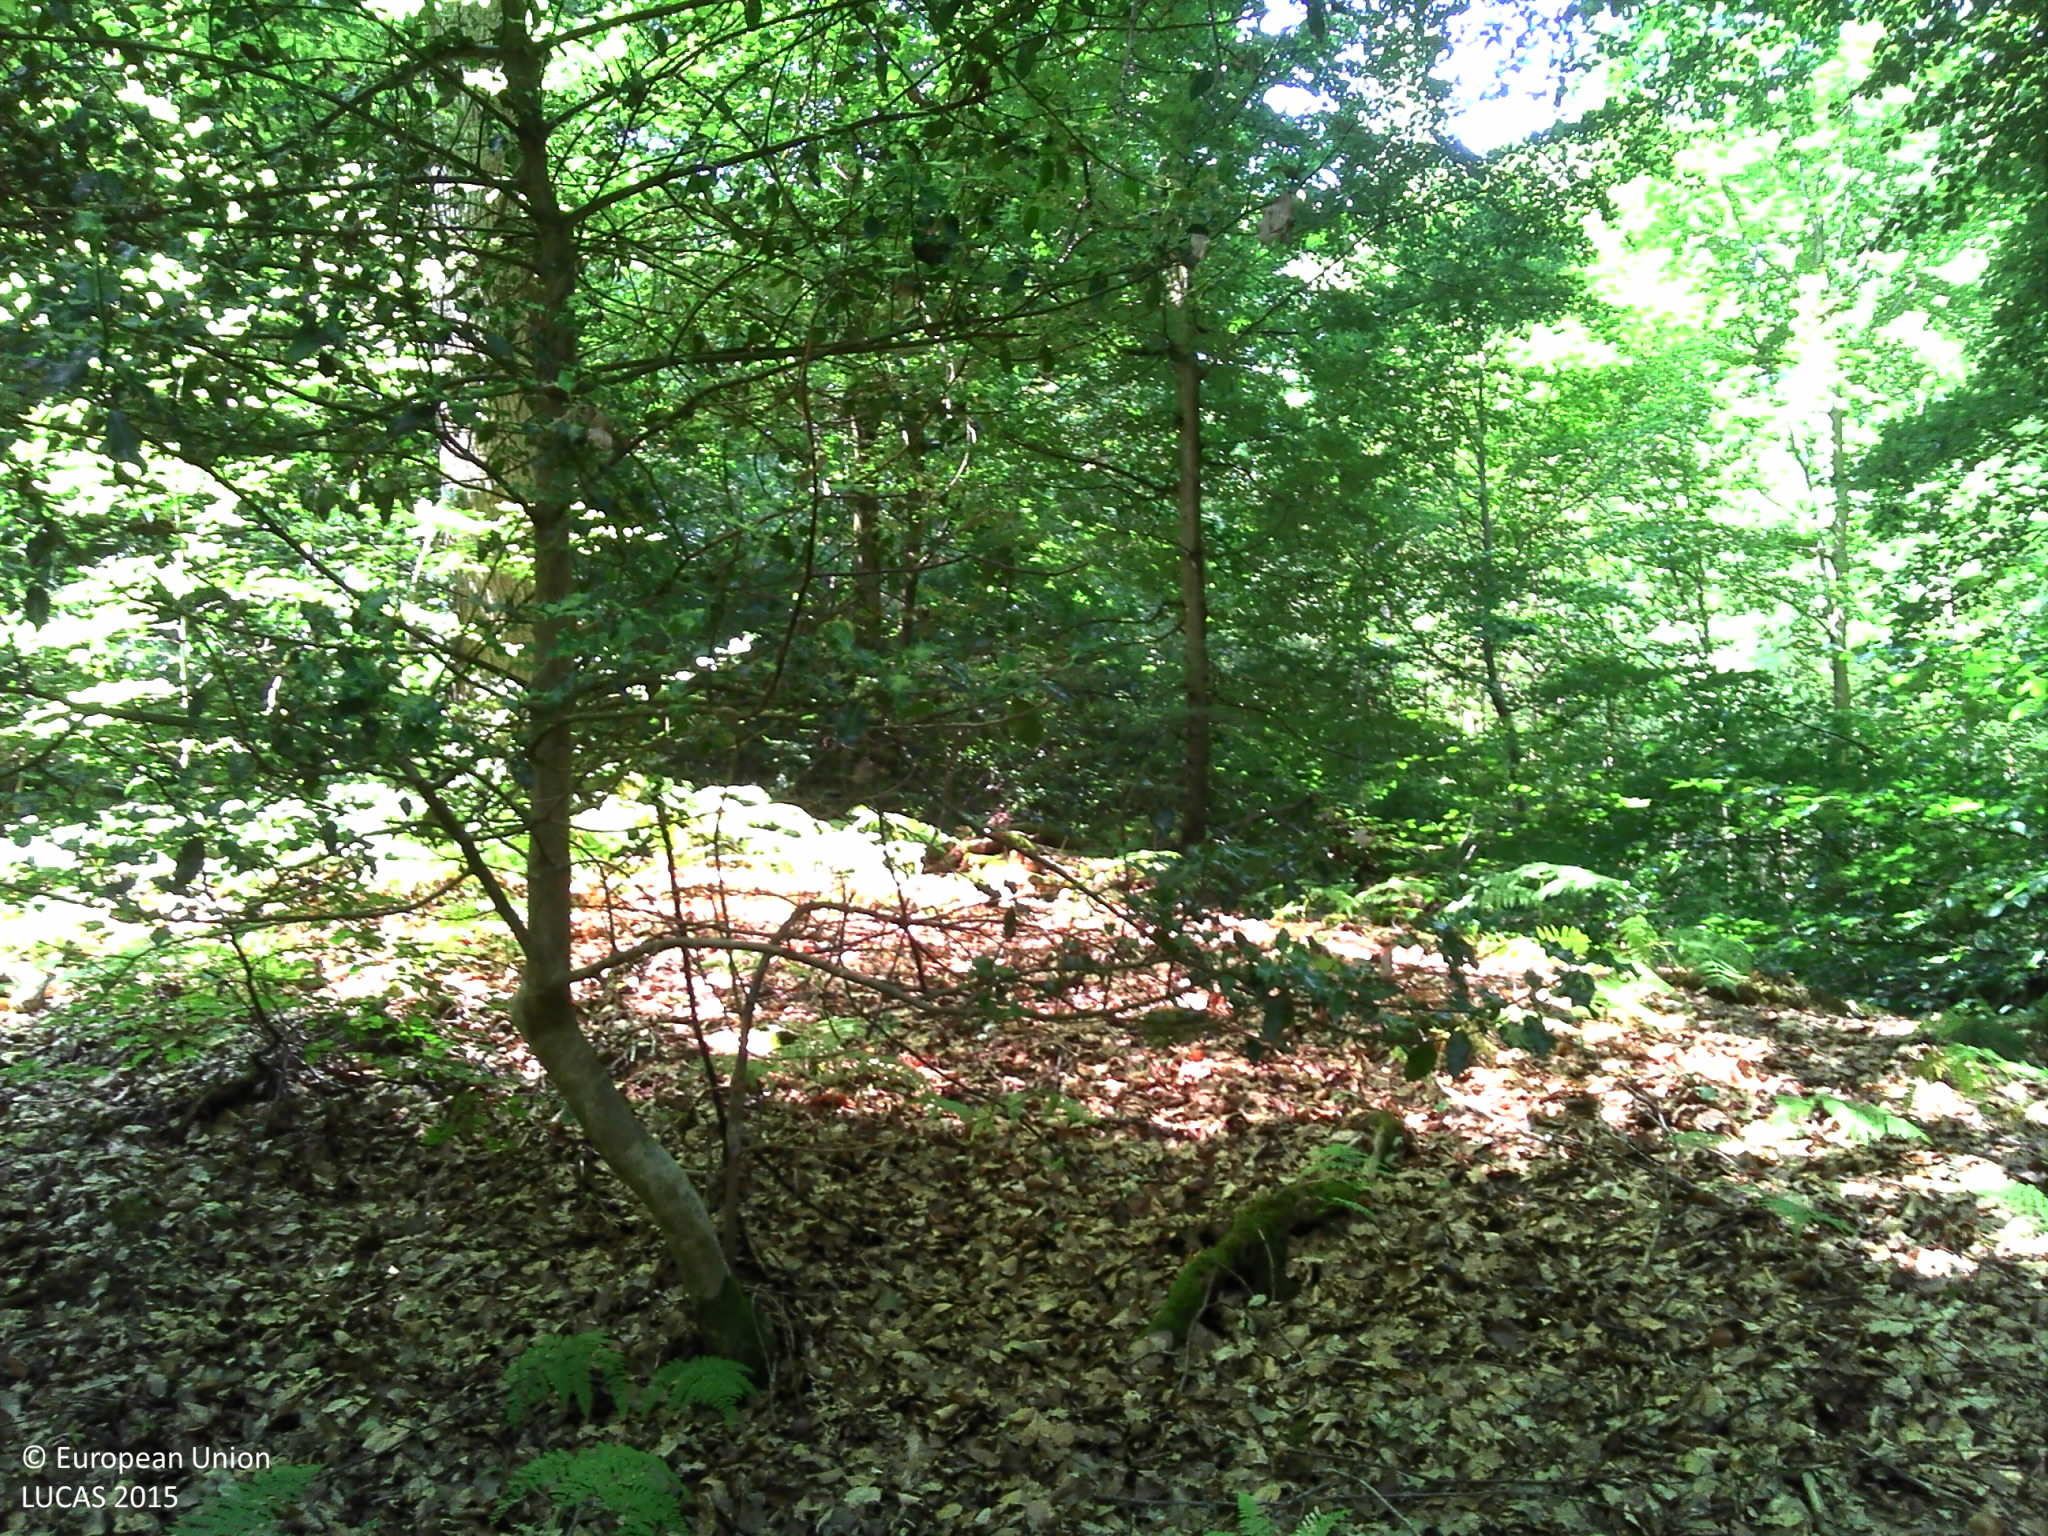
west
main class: Woodland
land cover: Broadleaved woodland
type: acidophilous oak and oak-birch forest
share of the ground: > 75 %
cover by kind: broadleaved forest trees 40 %, herbaceous plants 30 %, lichens and mosses 10 %, unconsolidated bare surface 10 %, consolidated bare surface 5 %
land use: Forestry
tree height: > 5 m
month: August
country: FR
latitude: 49.1335
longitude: 4.1707
